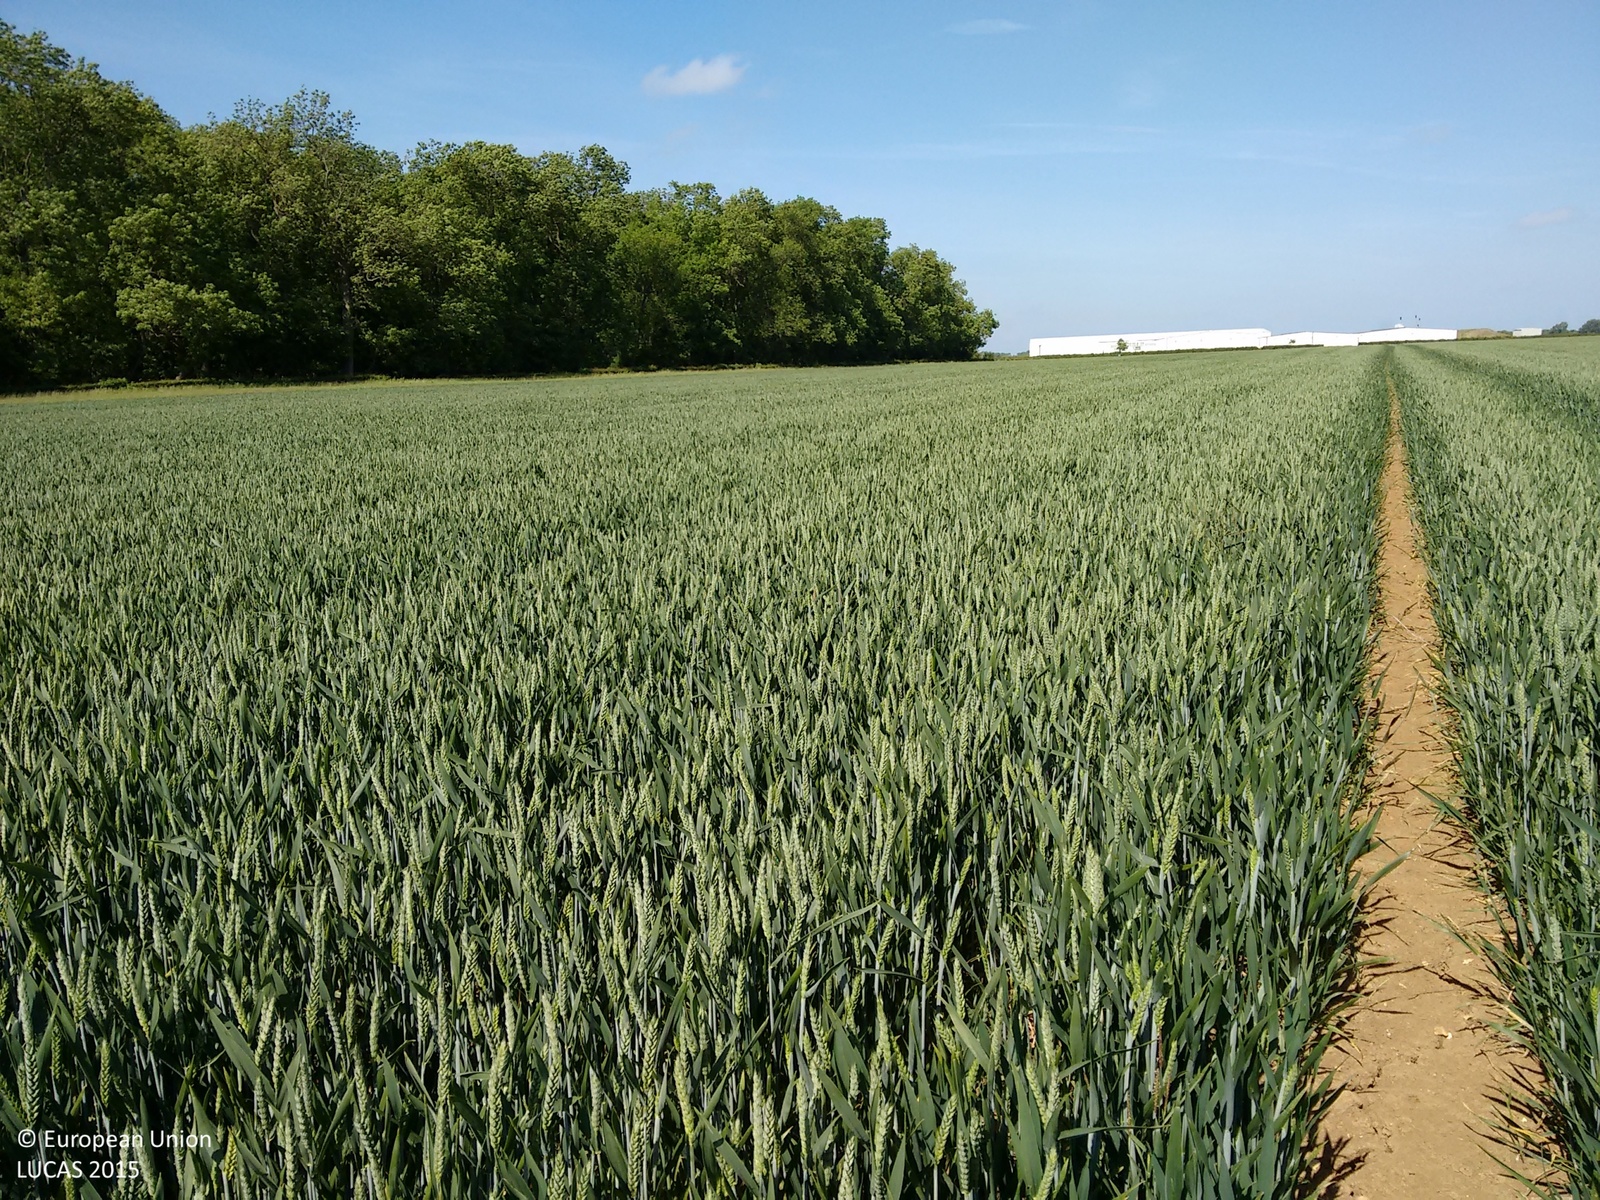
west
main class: Cropland
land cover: Common wheat
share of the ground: > 75 %
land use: Agriculture (excluding fallow land and kitchen gardens)
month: June
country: GB
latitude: 52.8273
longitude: -0.5912
